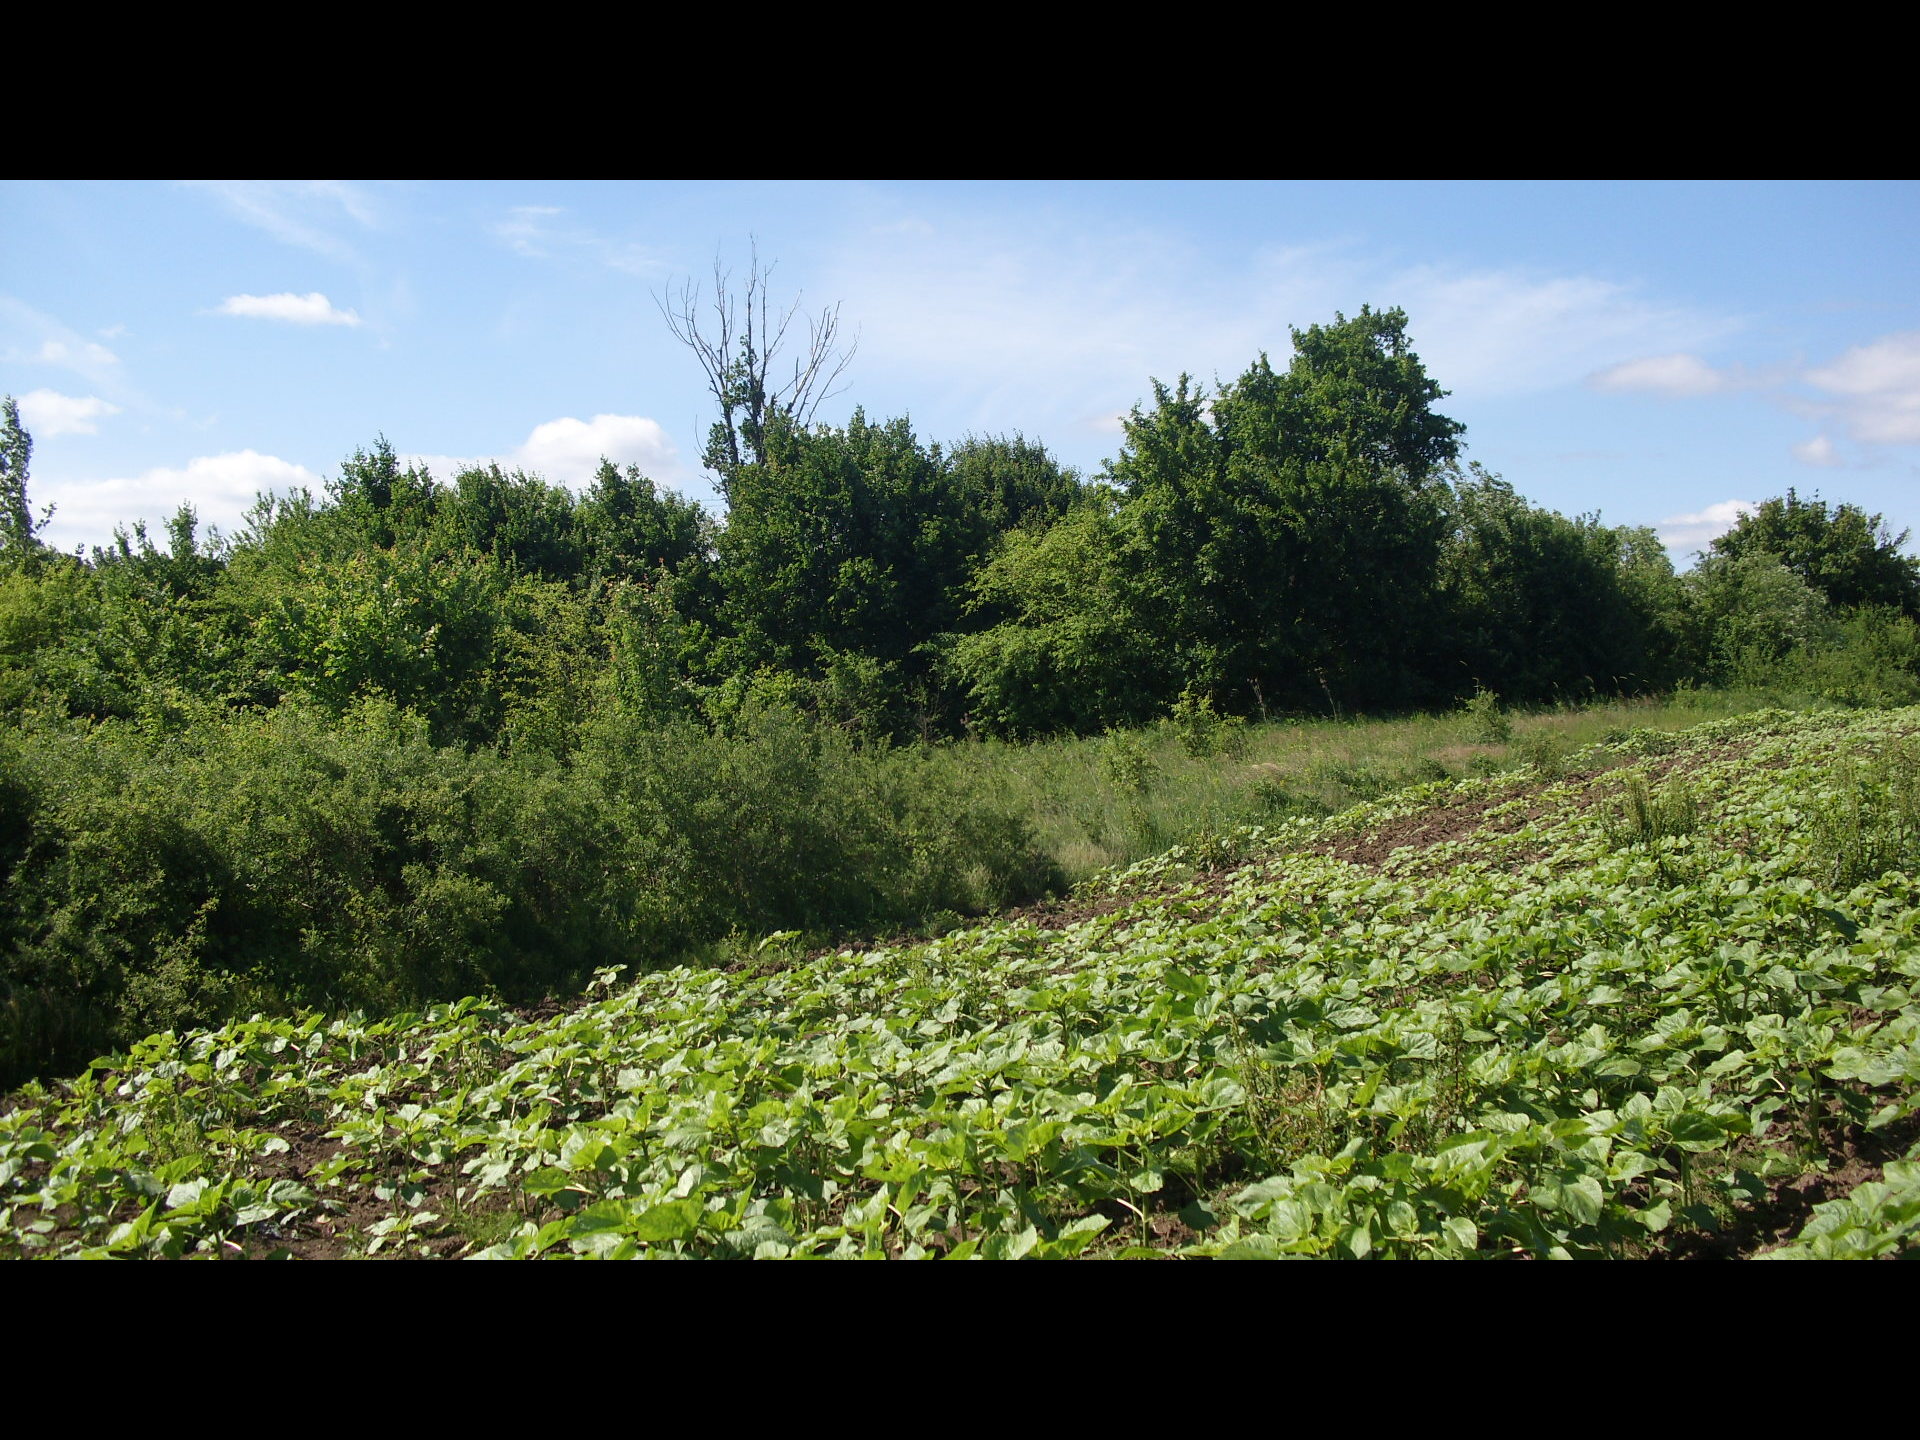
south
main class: Cropland
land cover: Sunflower
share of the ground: > 75 %
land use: Agriculture (excluding fallow land and kitchen gardens)
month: May
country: BG
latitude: 43.3987
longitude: 23.4391
